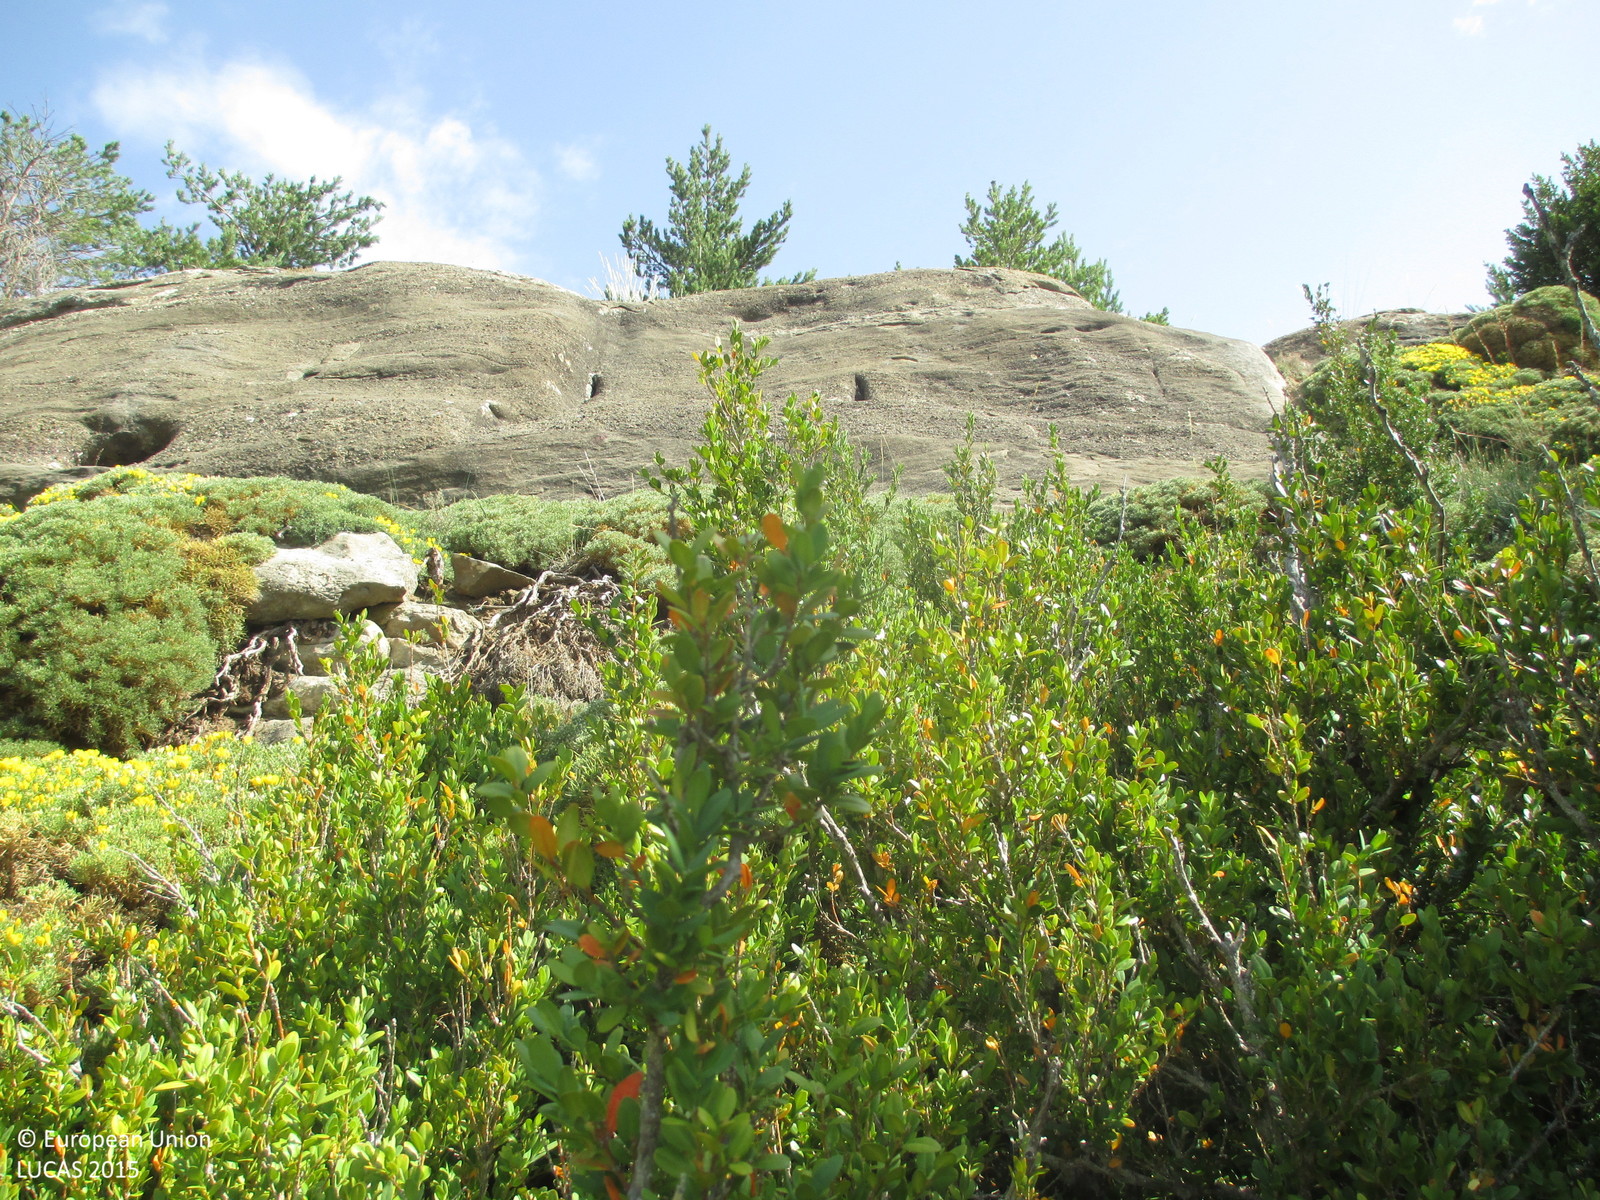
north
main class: Shrubland
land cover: Shrubland with sparse tree cover
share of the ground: > 75 %
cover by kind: shrubs 85 %, coniferous forest trees 5 %, herbaceous plants 5 %, consolidated bare surface 5 %
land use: Semi-natural and natural areas not in use
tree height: > 5 m
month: July
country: ES
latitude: 42.3558
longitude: -0.3801
